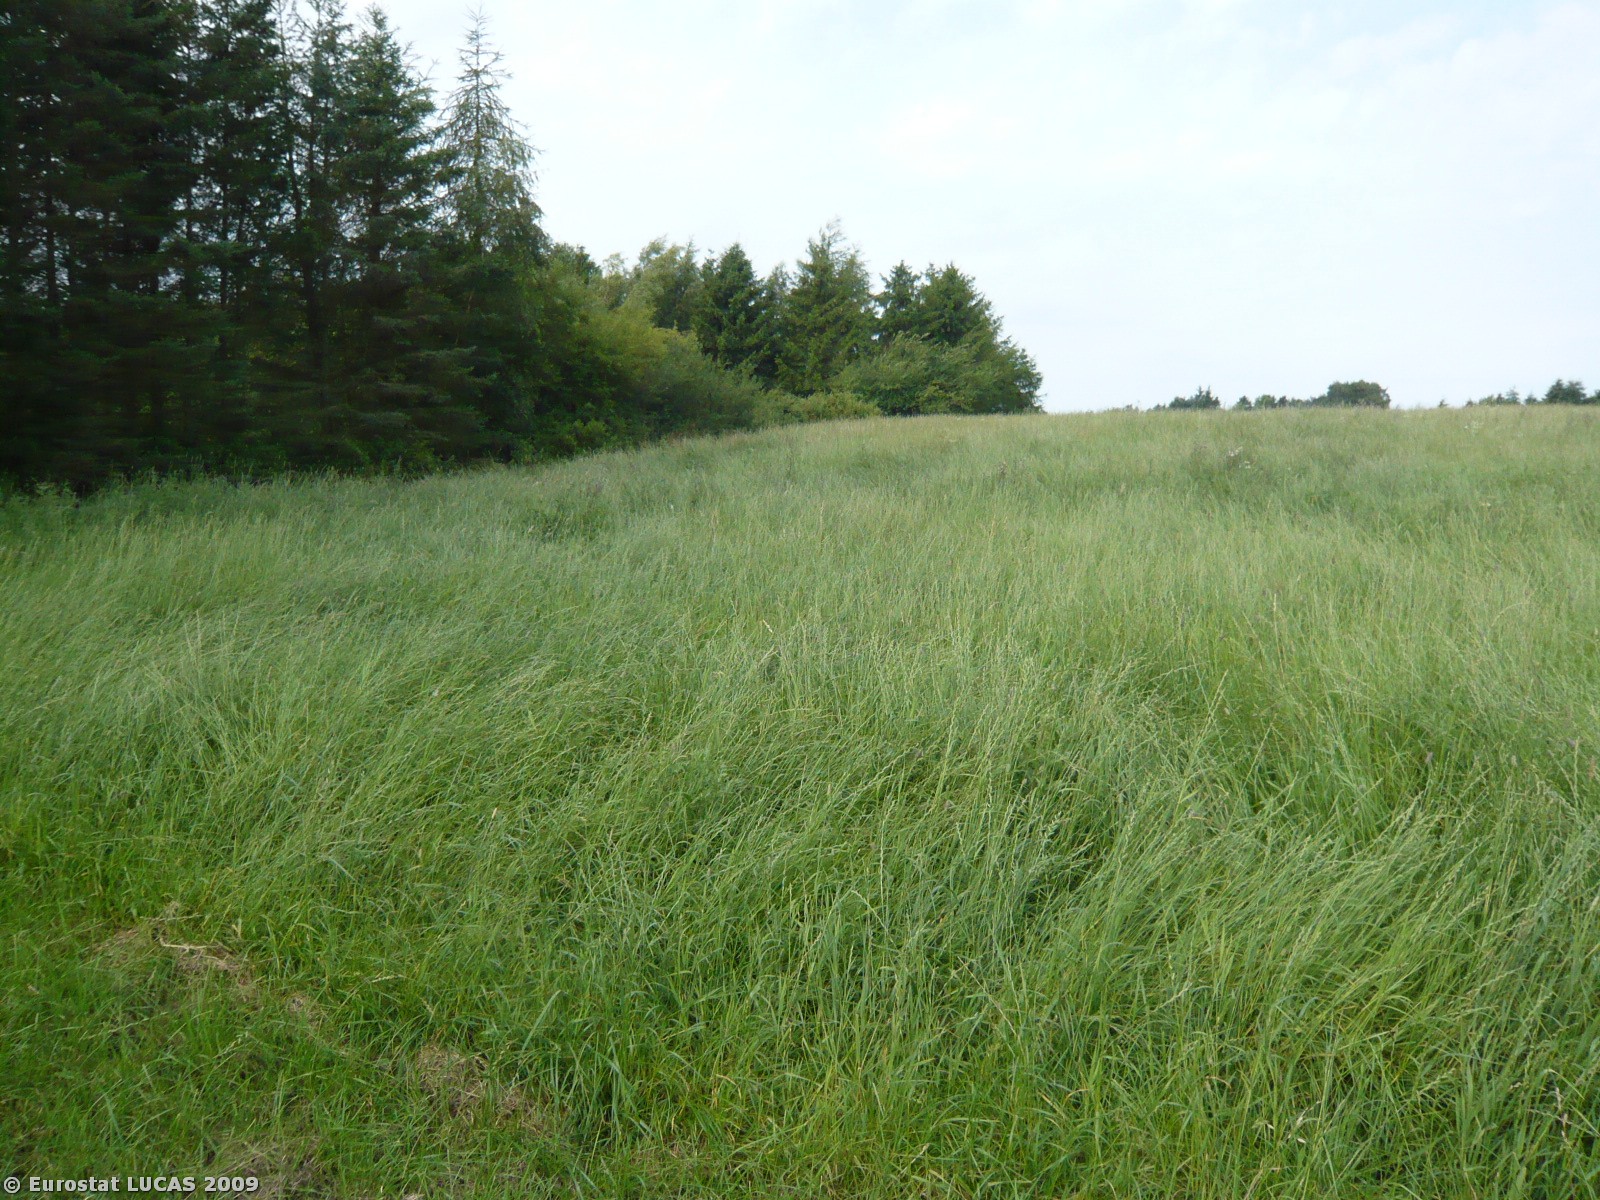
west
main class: Cropland
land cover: Barley
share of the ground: > 75 %
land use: Agriculture (excluding fallow land and kitchen gardens)
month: August
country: DK
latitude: 56.0257
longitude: 12.1640
